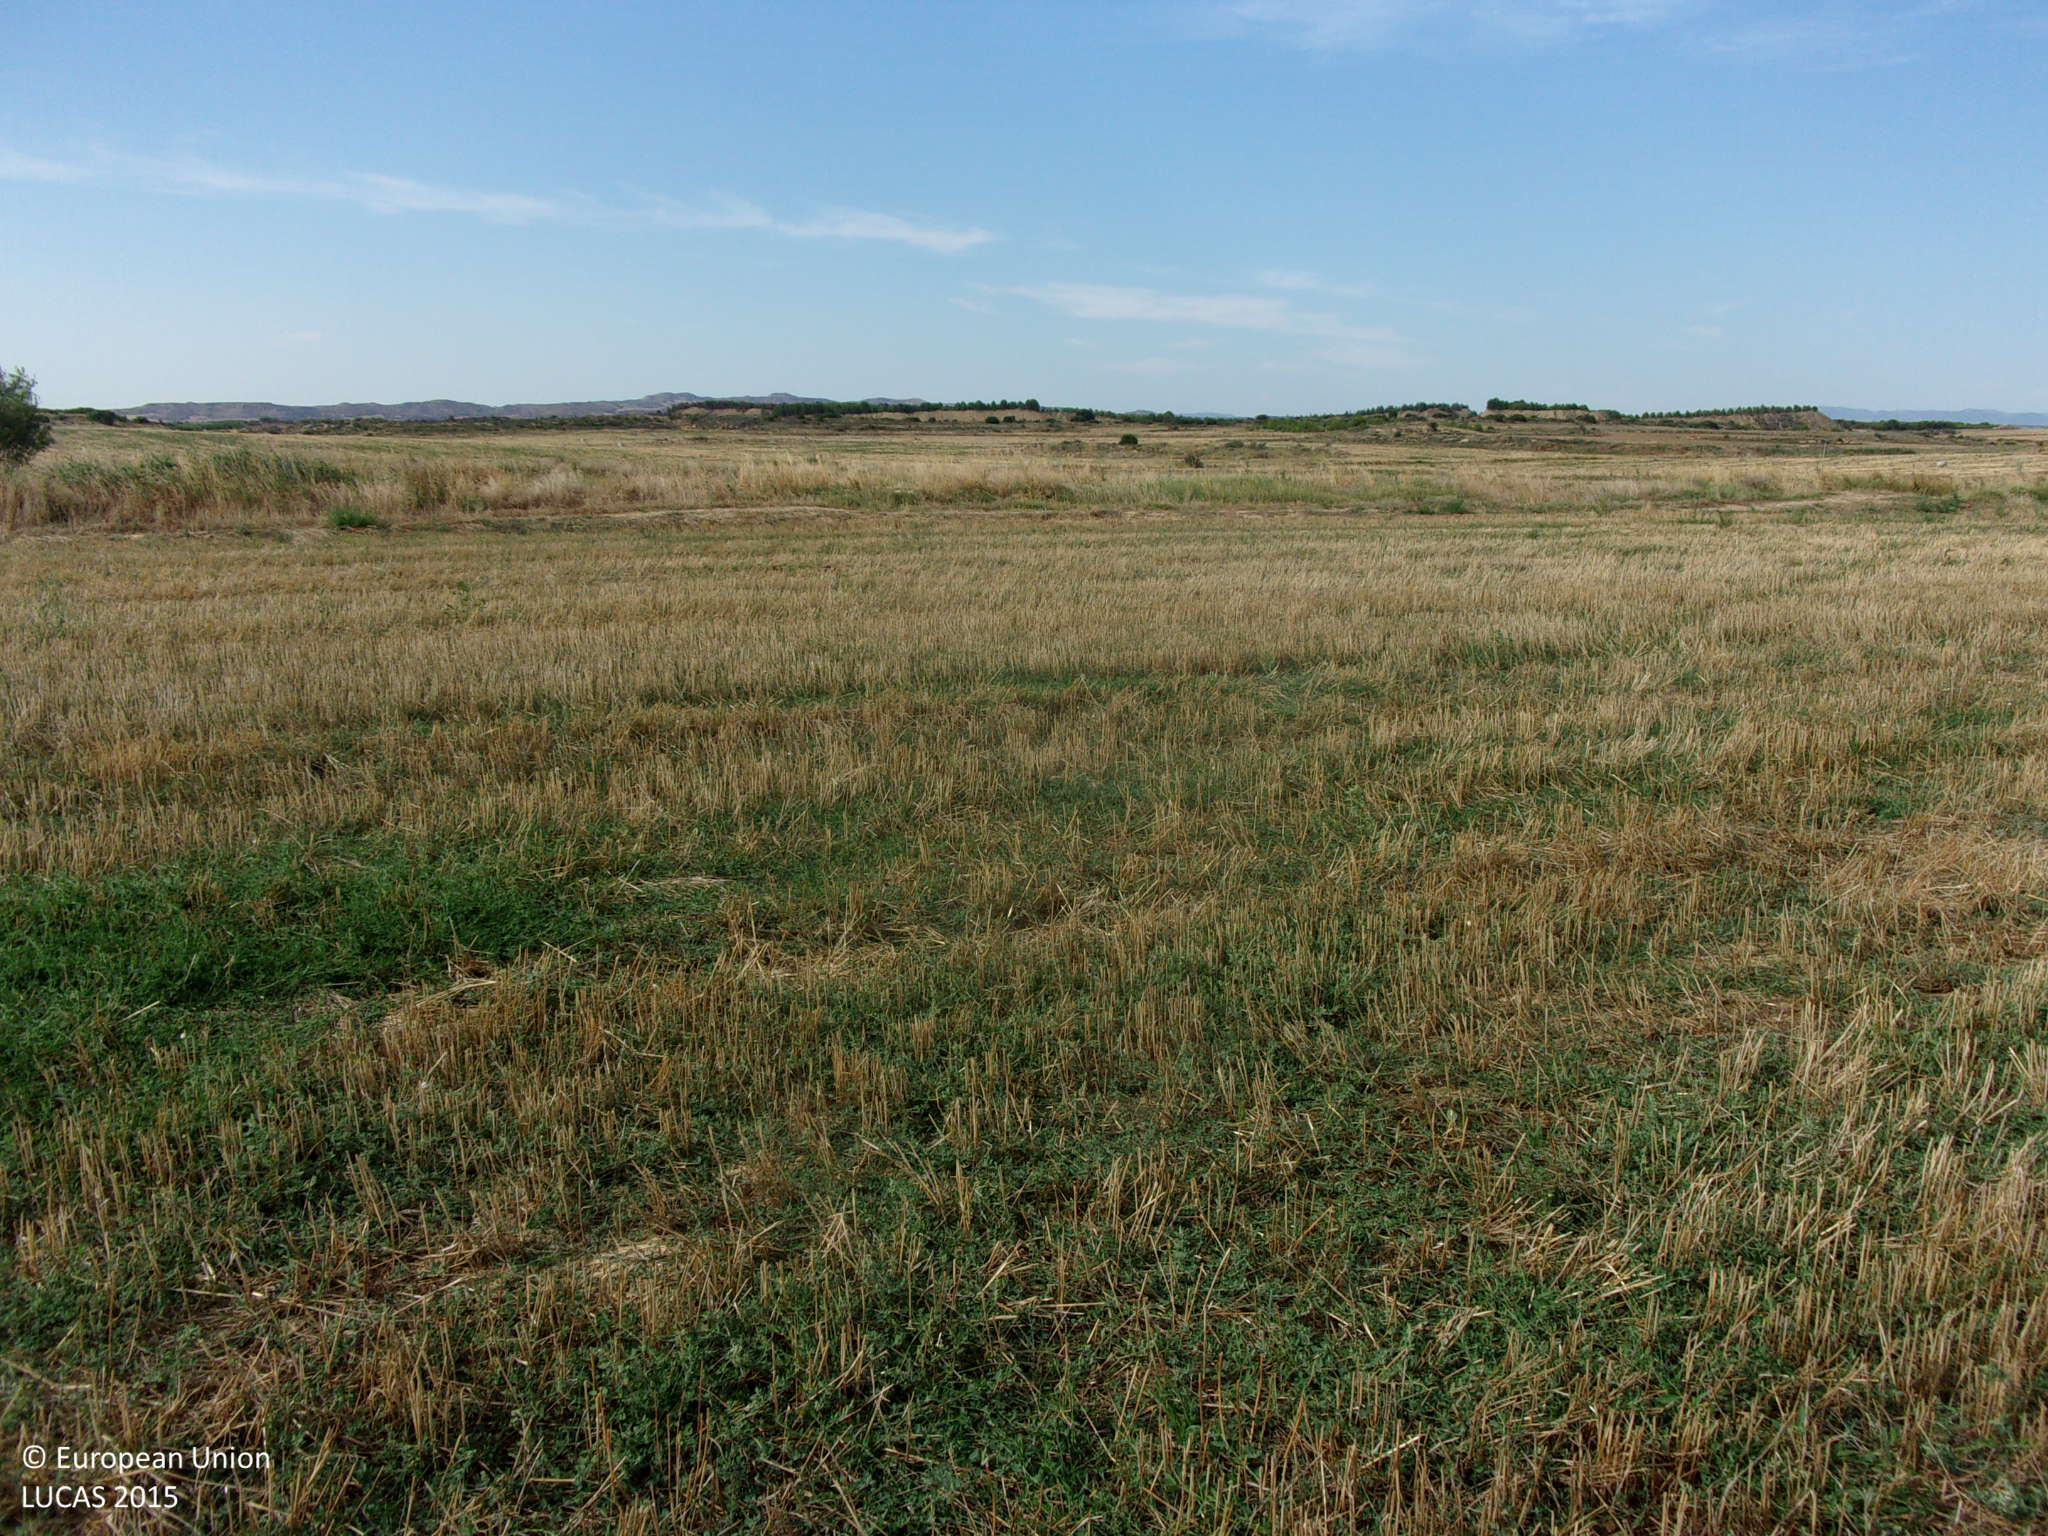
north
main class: Cropland
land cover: Durum wheat
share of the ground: < 10 %
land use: Agriculture (excluding fallow land and kitchen gardens)
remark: Harvested field
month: August
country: ES
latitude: 42.2199
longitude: -1.1381
